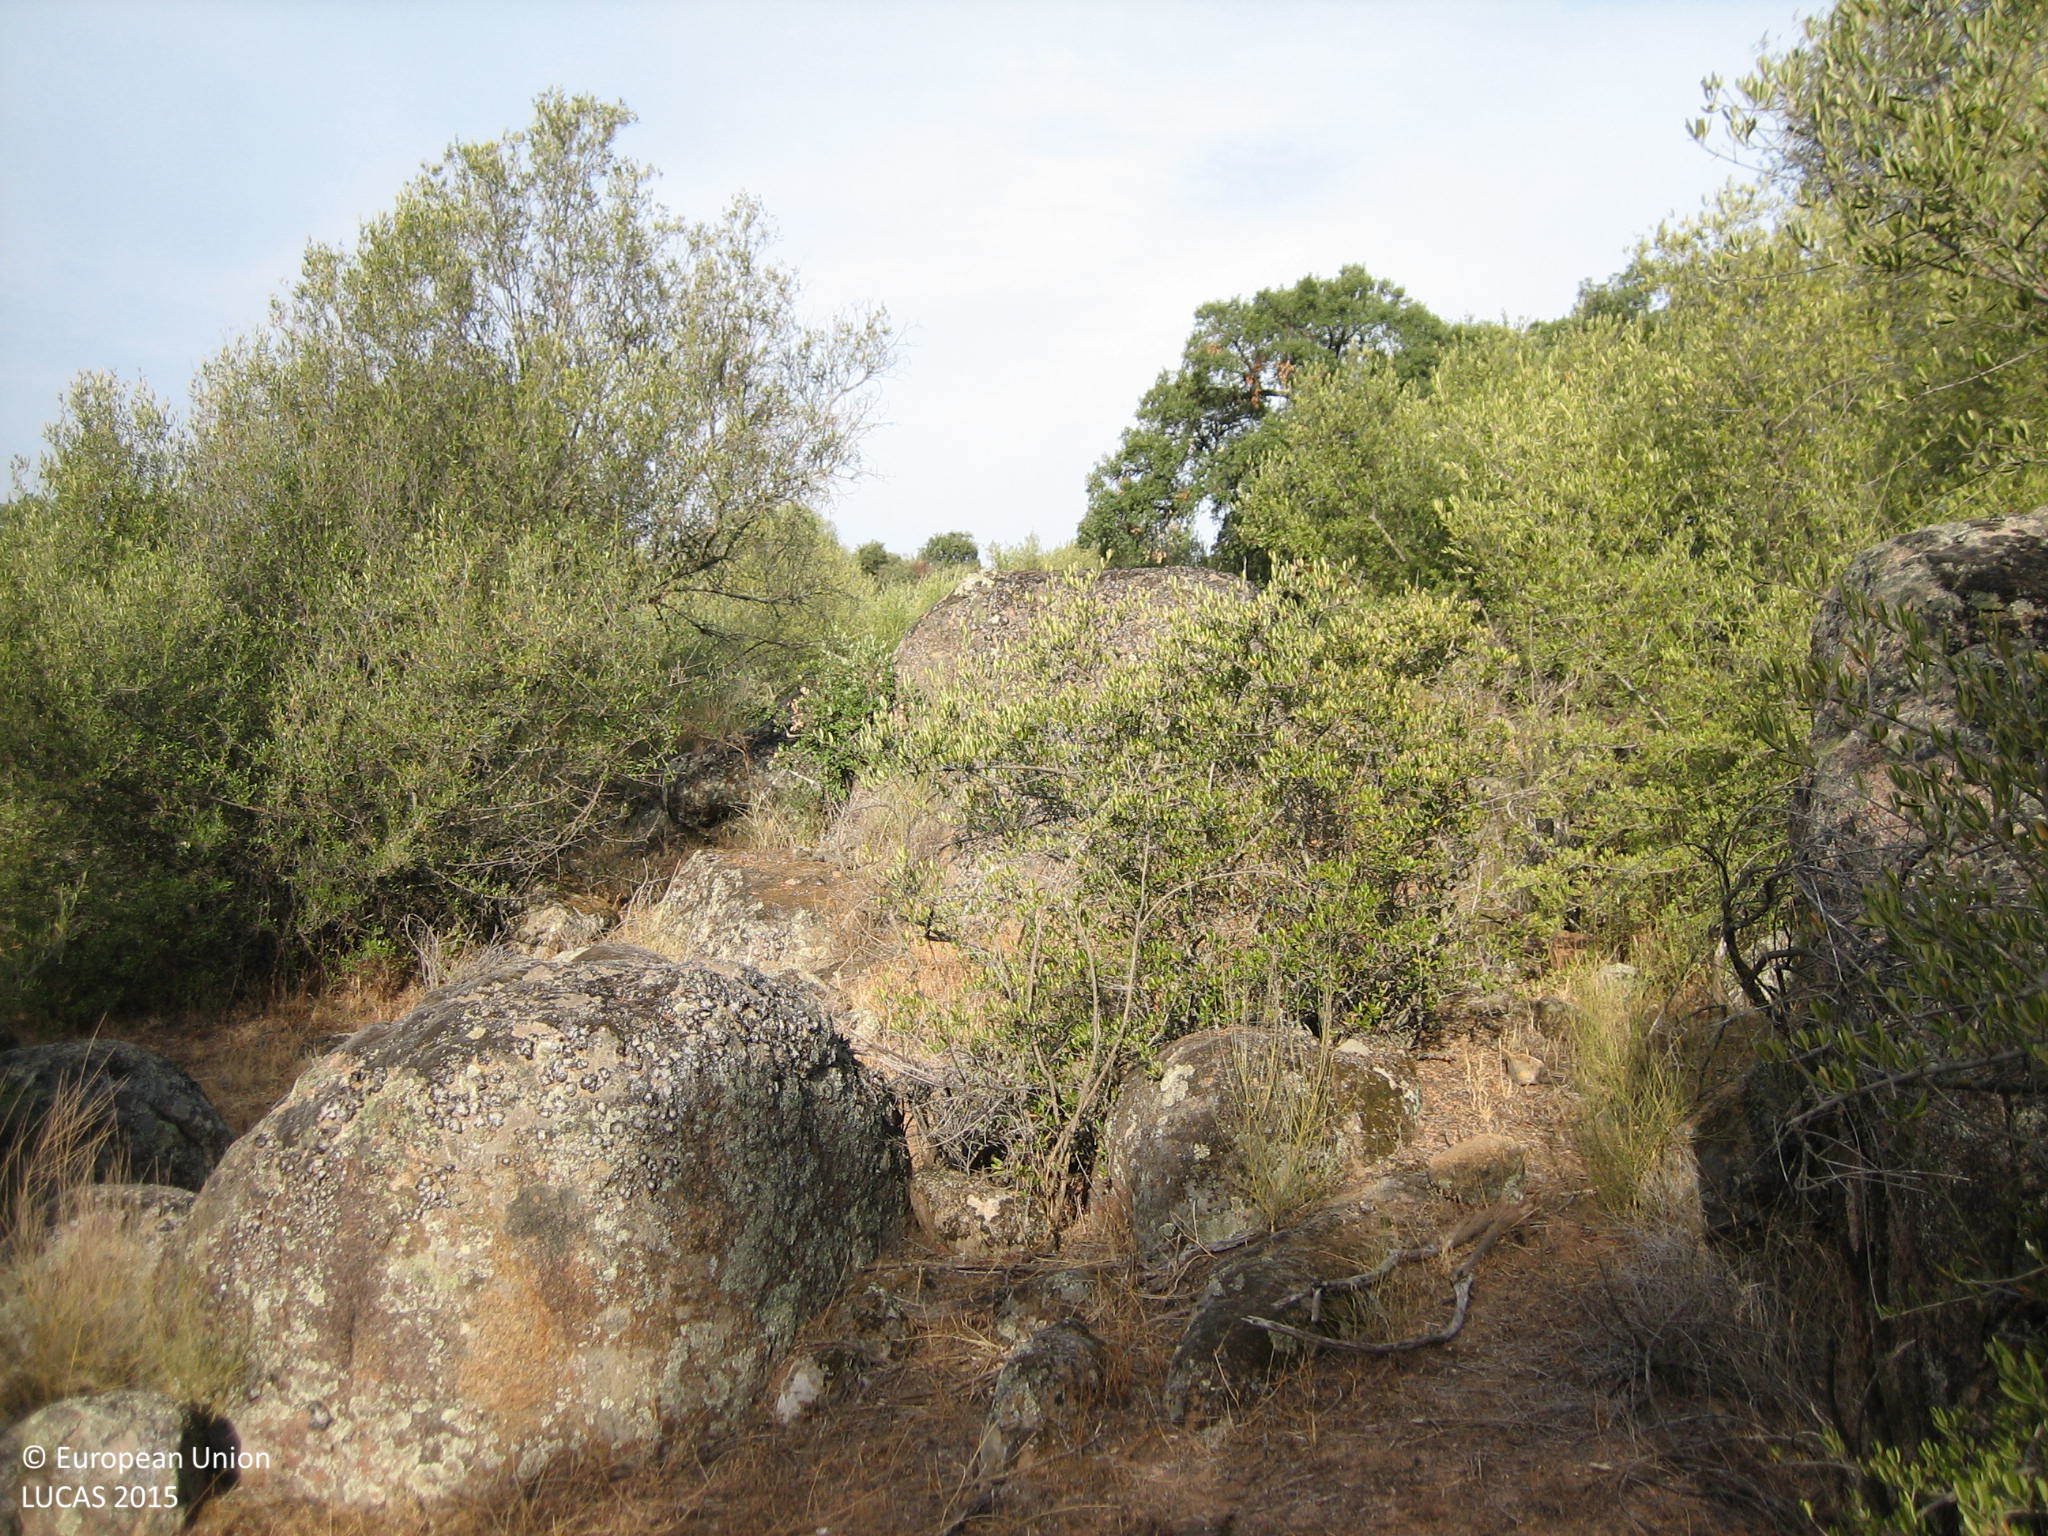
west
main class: Woodland
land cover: Broadleaved woodland
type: broadleaved evergreen forest
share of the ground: 50 - 75 %
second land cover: Grassland without tree/shrub cover
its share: 25 - 50 %
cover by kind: broadleaved forest trees 50 %, herbaceous plants 25 %, consolidated bare surface 20 %, shrubs 5 %
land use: Forestry
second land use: Agriculture (excluding fallow land and kitchen gardens)
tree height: > 5 m
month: September
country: ES
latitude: 38.5583
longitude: -6.8503
